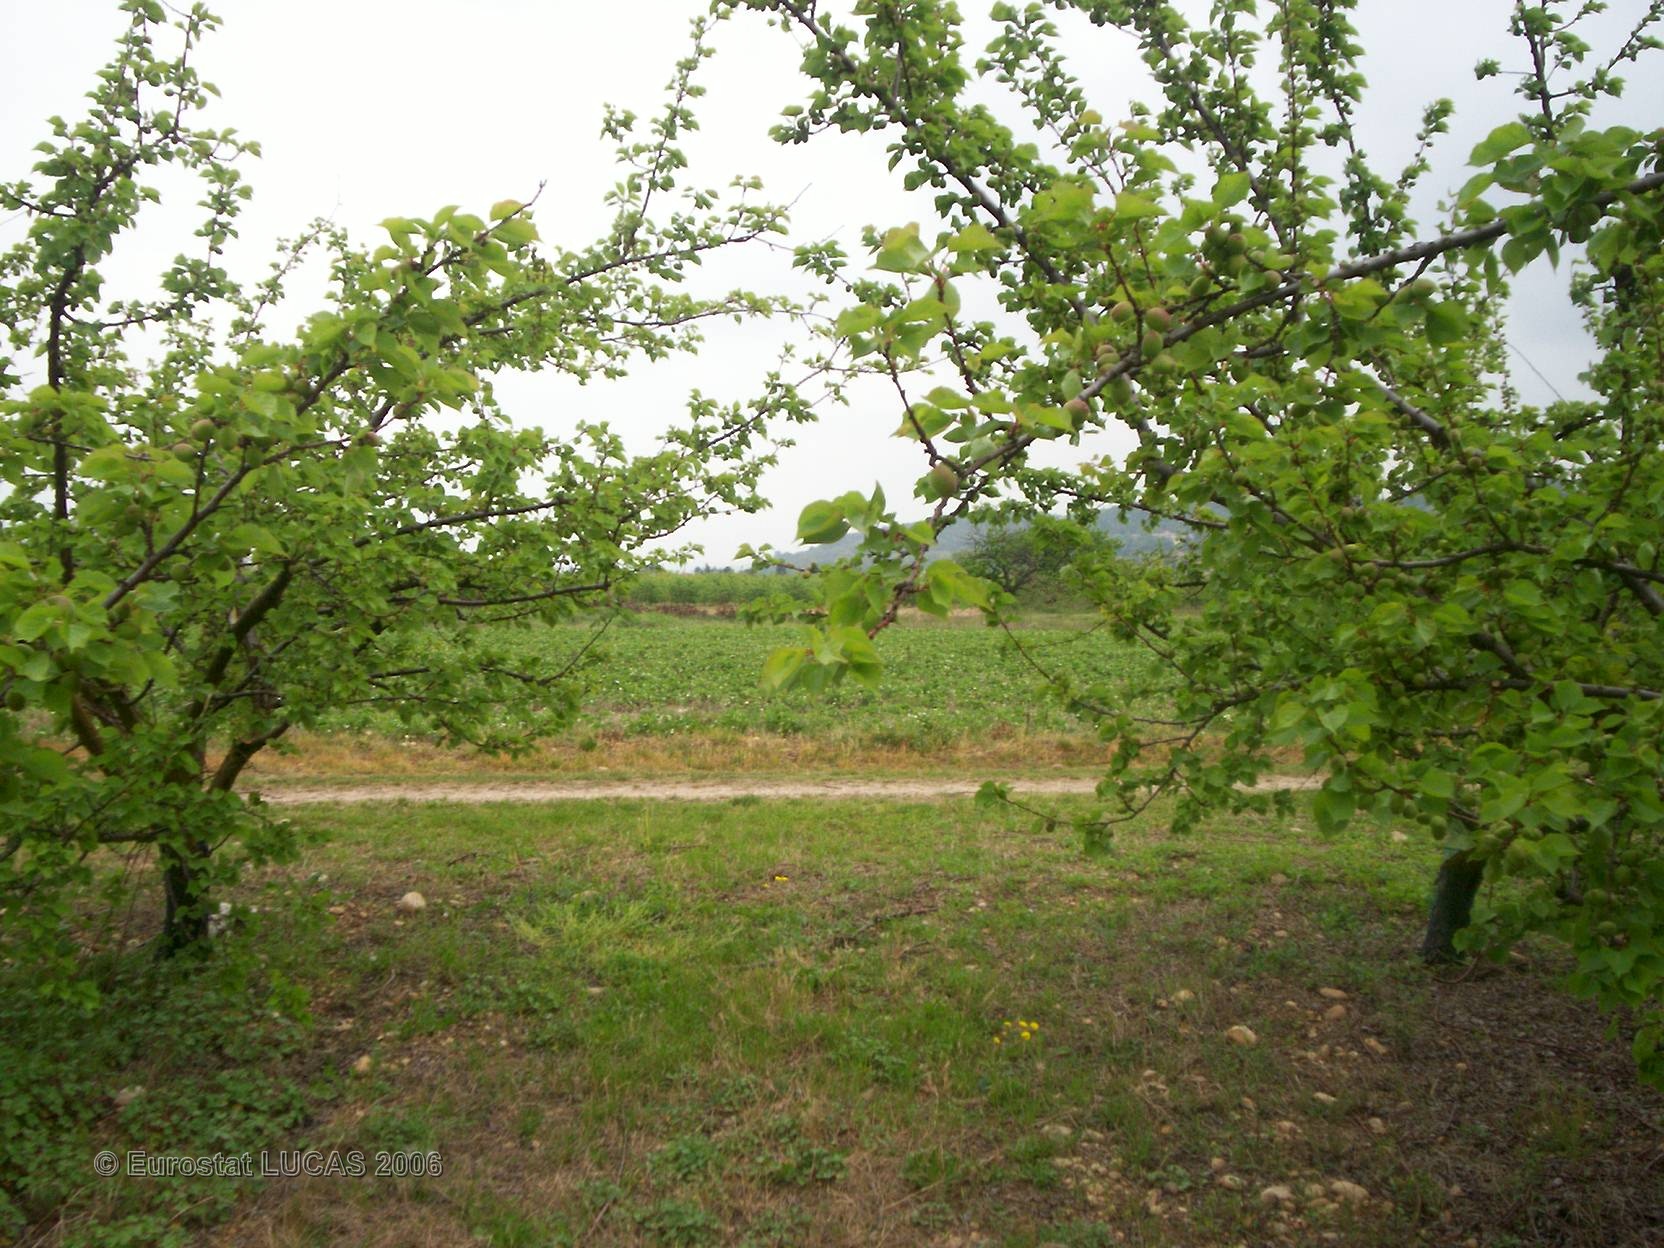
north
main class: Cropland
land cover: Other fruit trees and berries
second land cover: Grassland with sparse tree/shrub cover
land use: Agriculture (excluding fallow land and kitchen gardens)
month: April
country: FR
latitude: 45.3754
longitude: 4.7817
